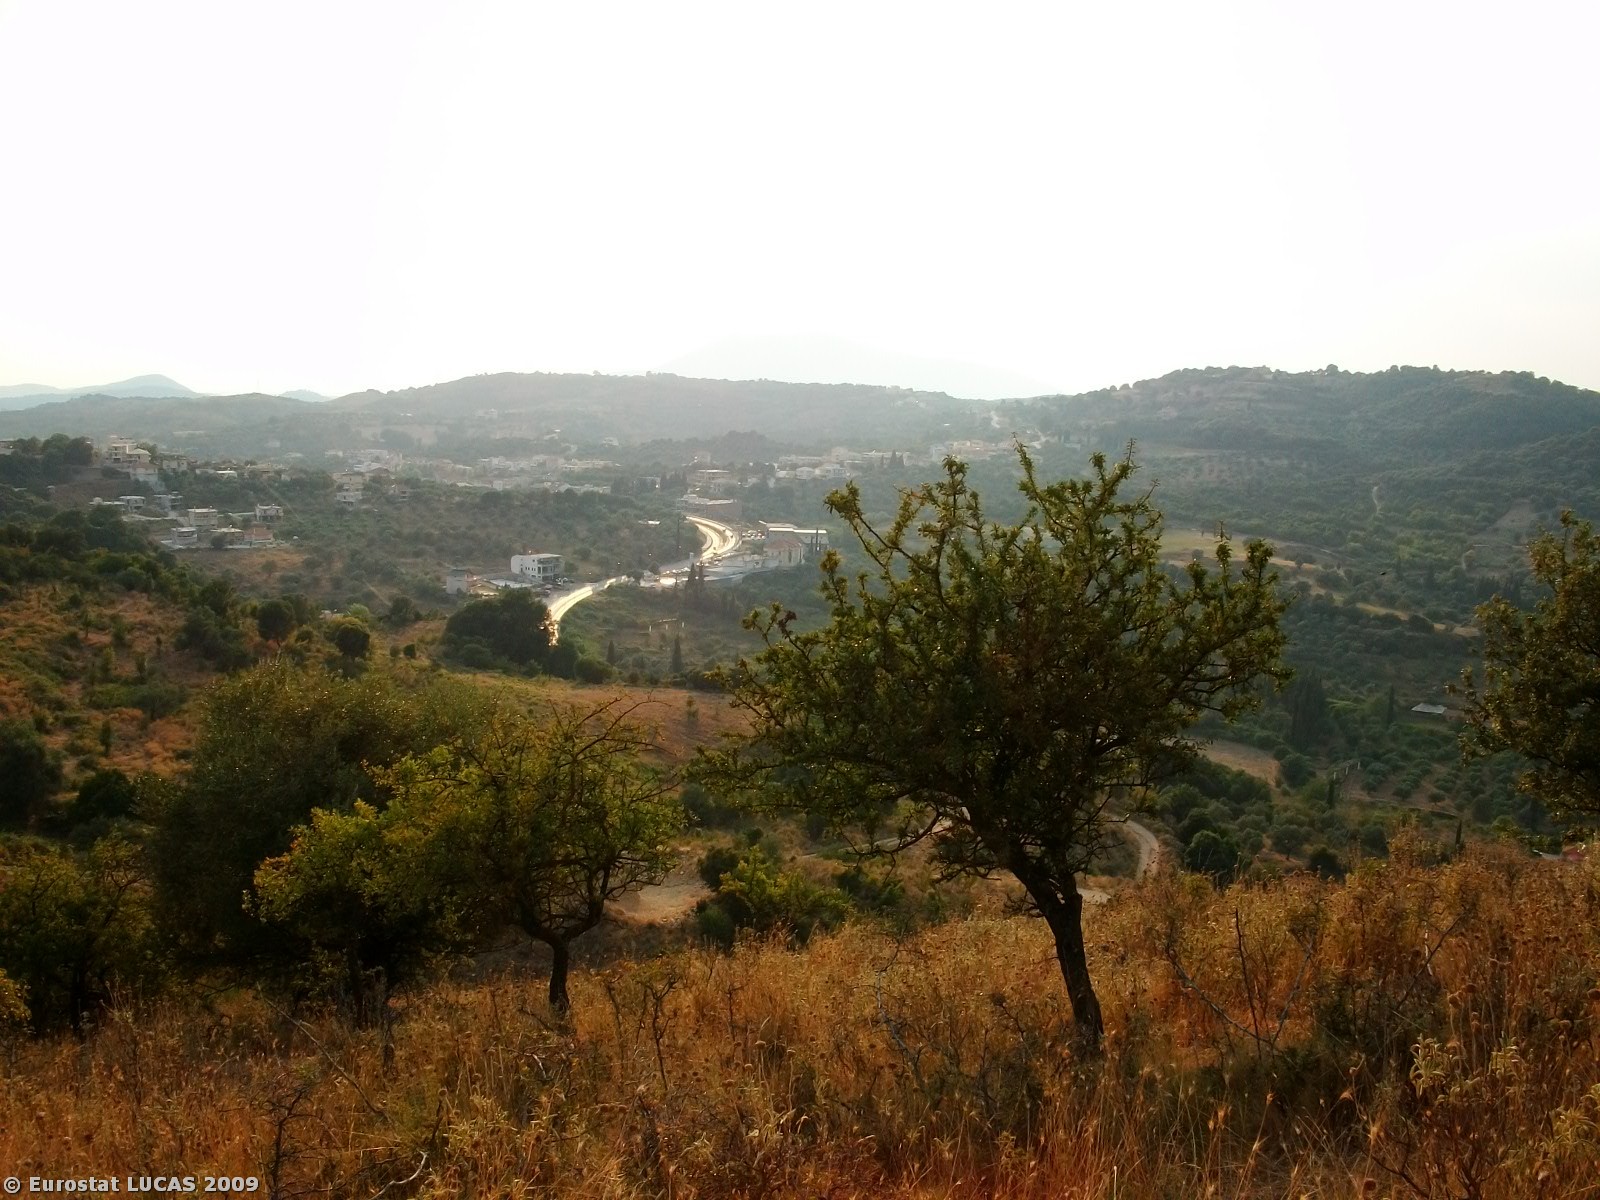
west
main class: Grassland
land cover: Grassland with sparse tree/shrub cover
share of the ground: > 75 %
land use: Unused
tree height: < 5 m
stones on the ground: > 50 %
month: August
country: GR
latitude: 39.5419
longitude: 20.2954
